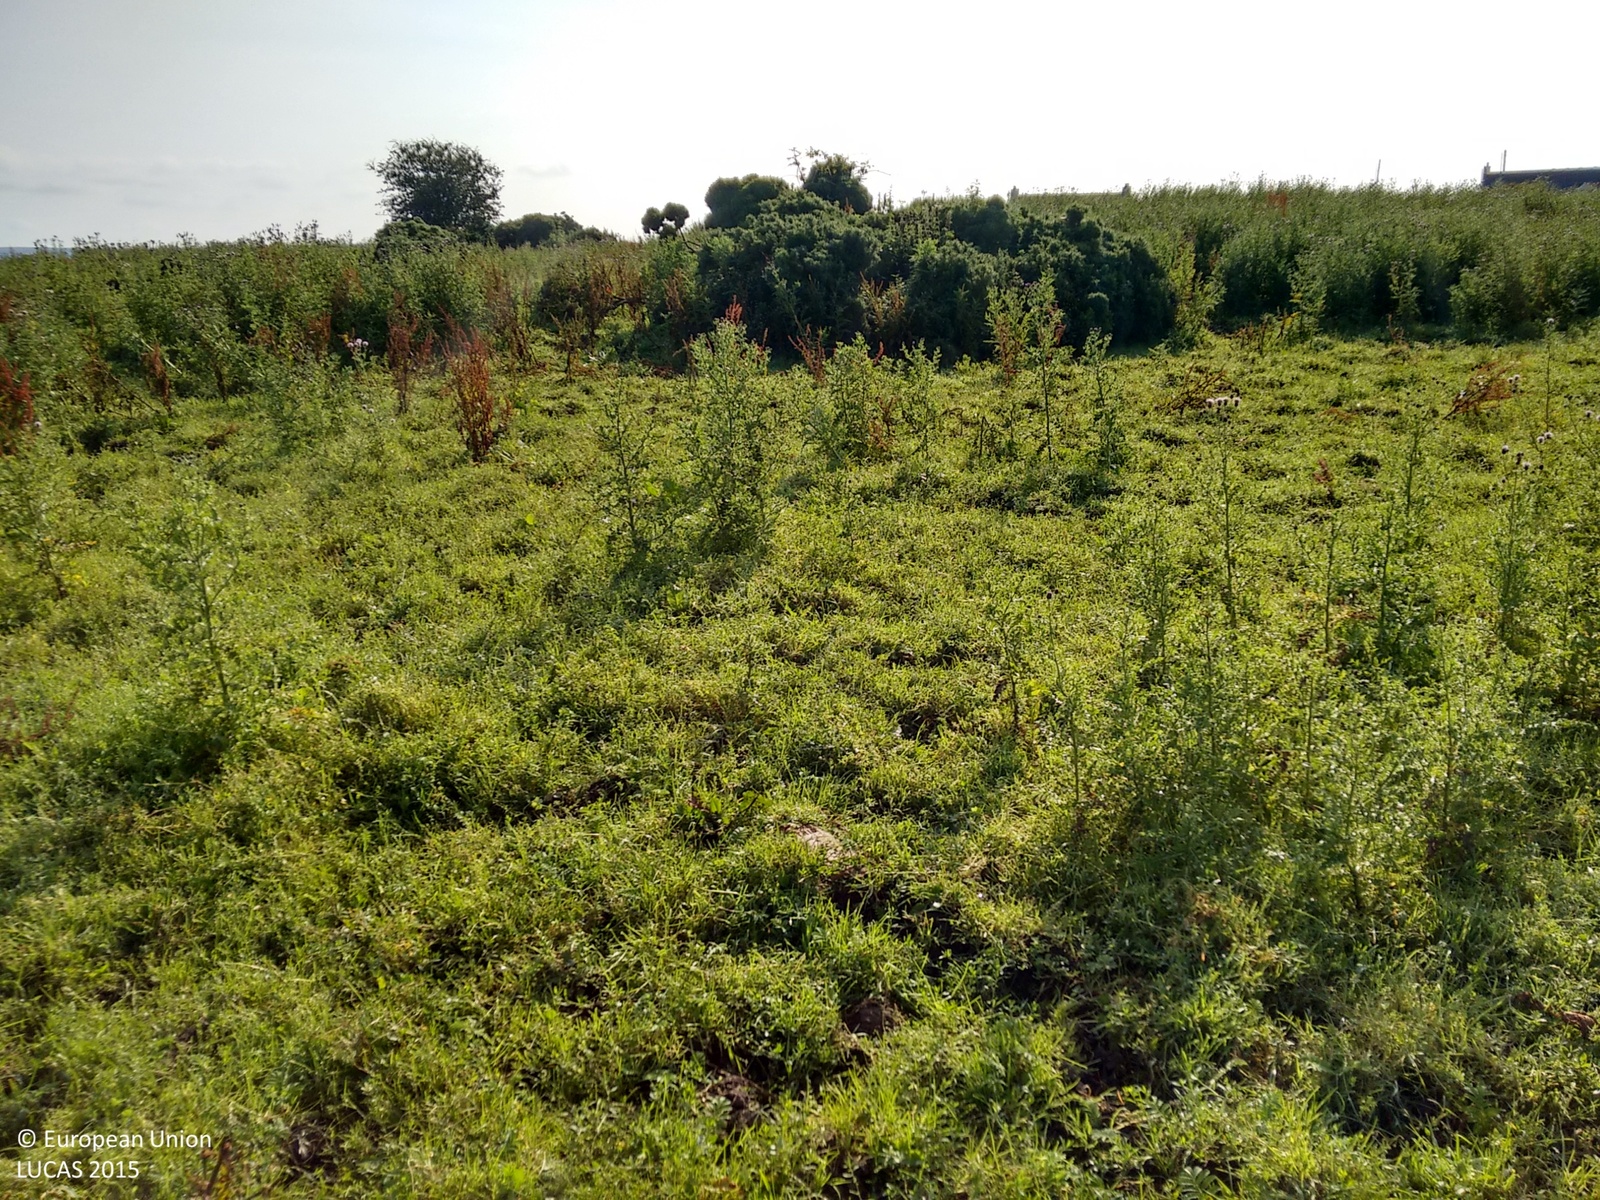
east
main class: Grassland
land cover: Grassland with sparse tree/shrub cover
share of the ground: > 75 %
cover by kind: herbaceous plants 85 %, shrubs 10 %, broadleaved forest trees 5 %
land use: Agriculture (excluding fallow land and kitchen gardens)
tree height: < 5 m
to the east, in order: Abandoned hedges; Fences; Grassland with sparse tree/shrub cover; Artificial constructions; Grassland with sparse tree/shrub cover; Tracks; Grassland with sparse tree/shrub cover; Electric lines; Grassland without tree/shrub cover; Fences; Dry stone walls; Grass margins; Tracks; Grass margins; Fences; Spontaneously vegetated surfaces; Artificial constructions in urban areas
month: August
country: GB
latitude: 54.9402
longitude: -5.0855
